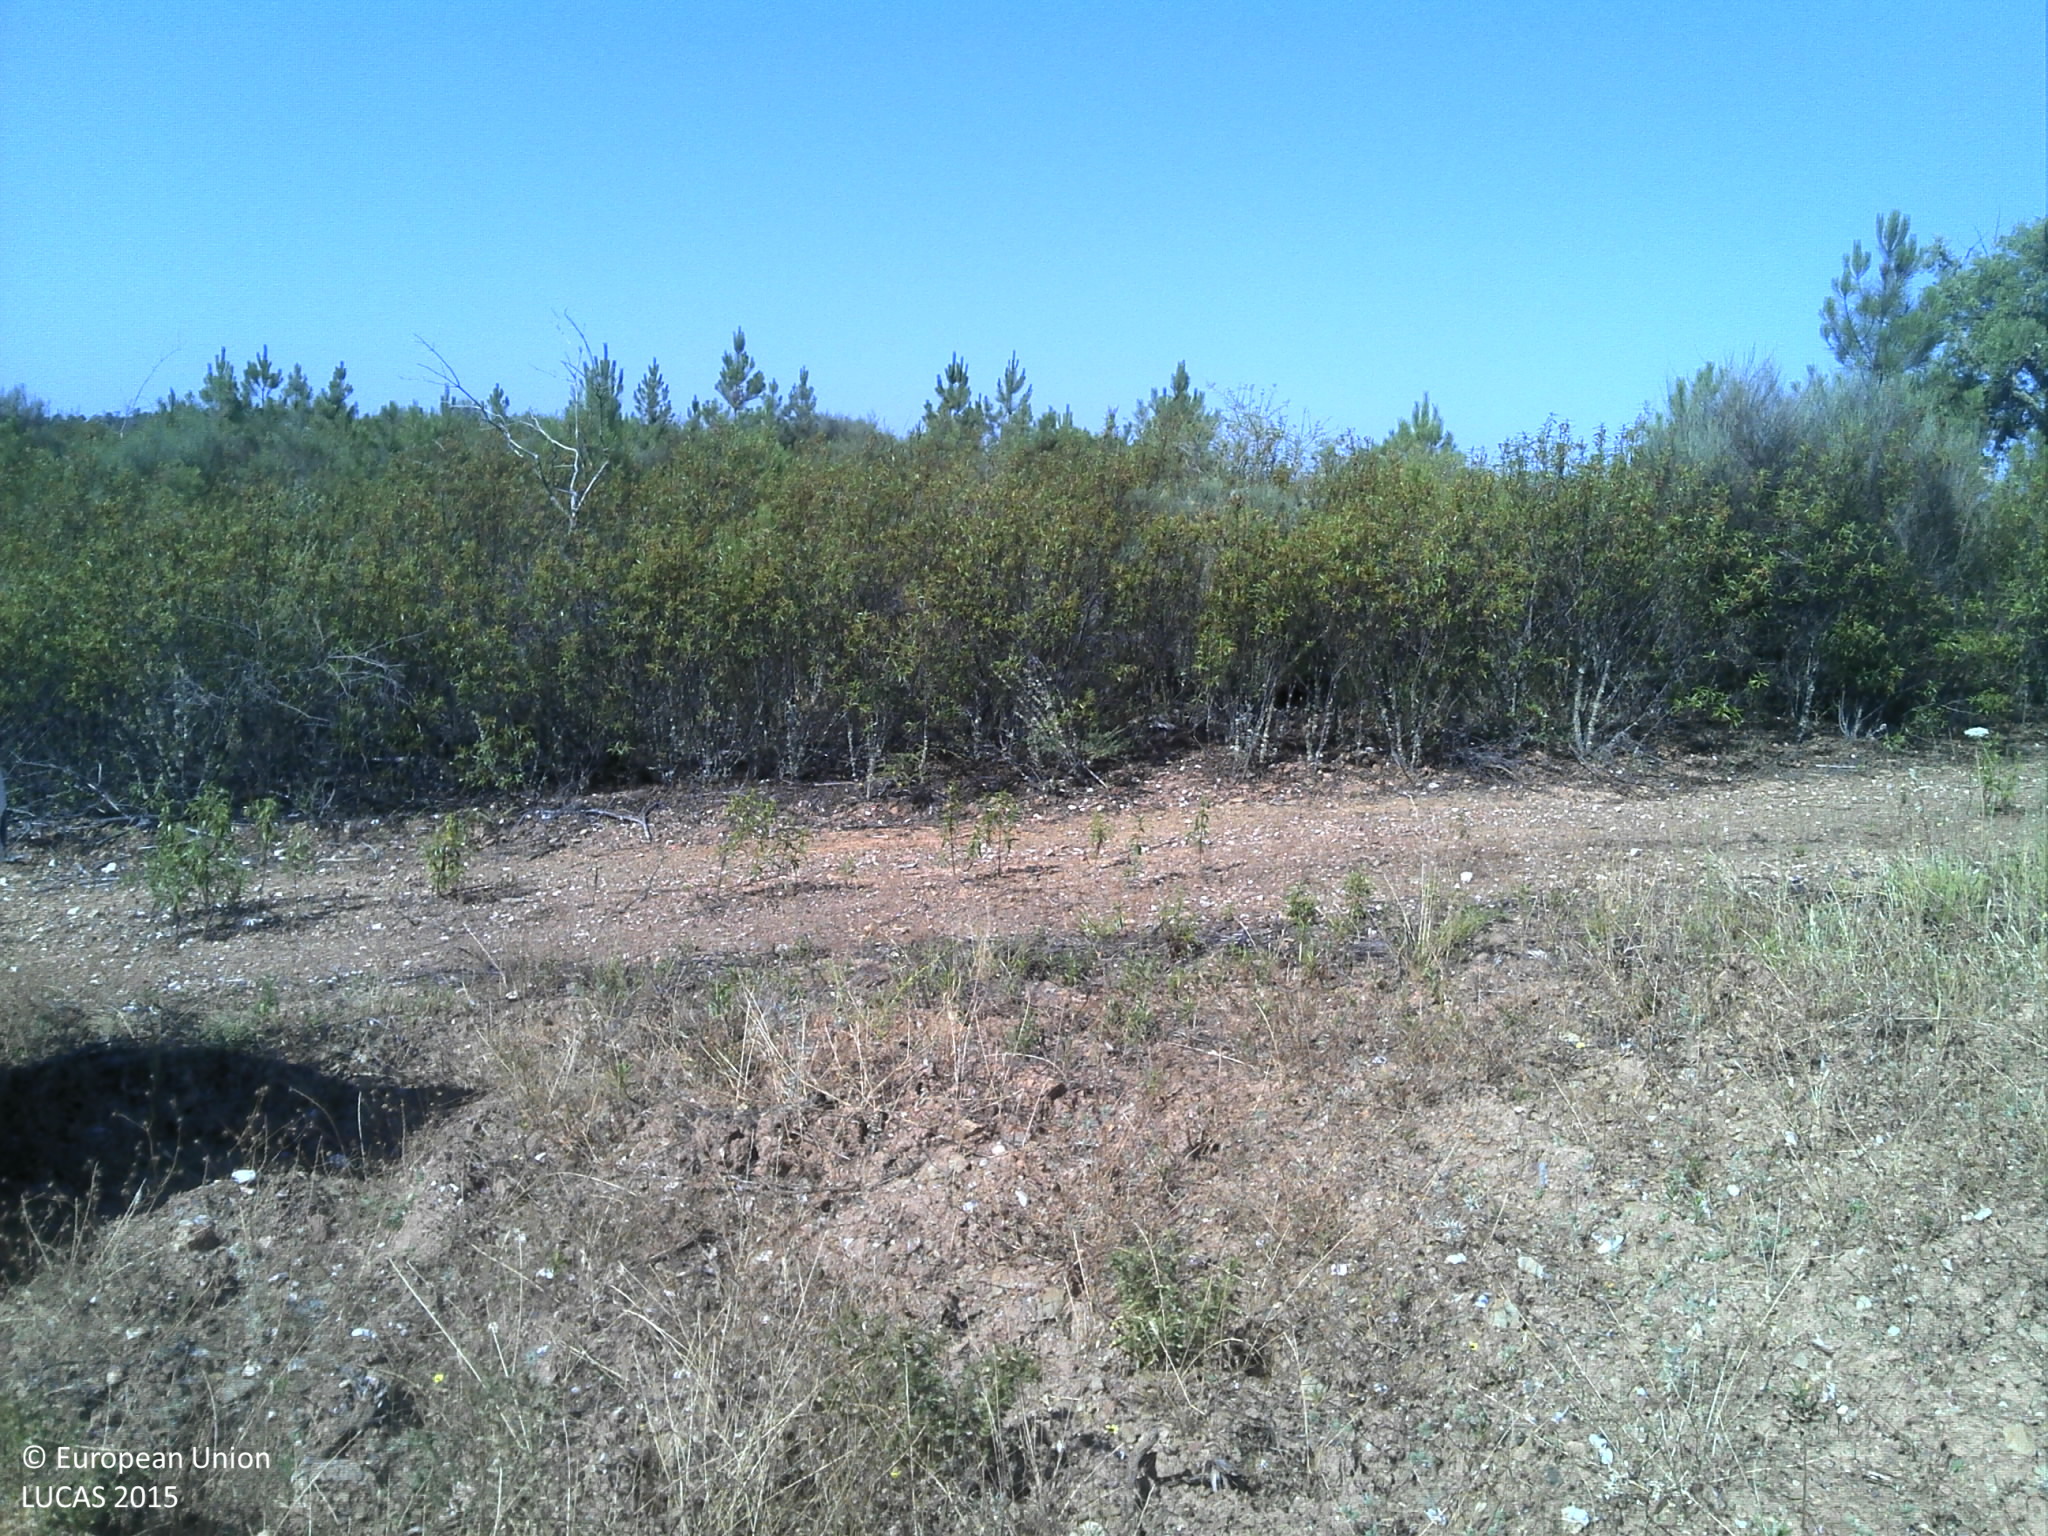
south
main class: Grassland
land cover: Spontaneously vegetated surfaces
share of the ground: 10 - 25 %
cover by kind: unconsolidated bare surface 85 %, herbaceous plants 15 %
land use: Agriculture (excluding fallow land and kitchen gardens)
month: June
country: PT
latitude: 39.9916
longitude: -7.0862
